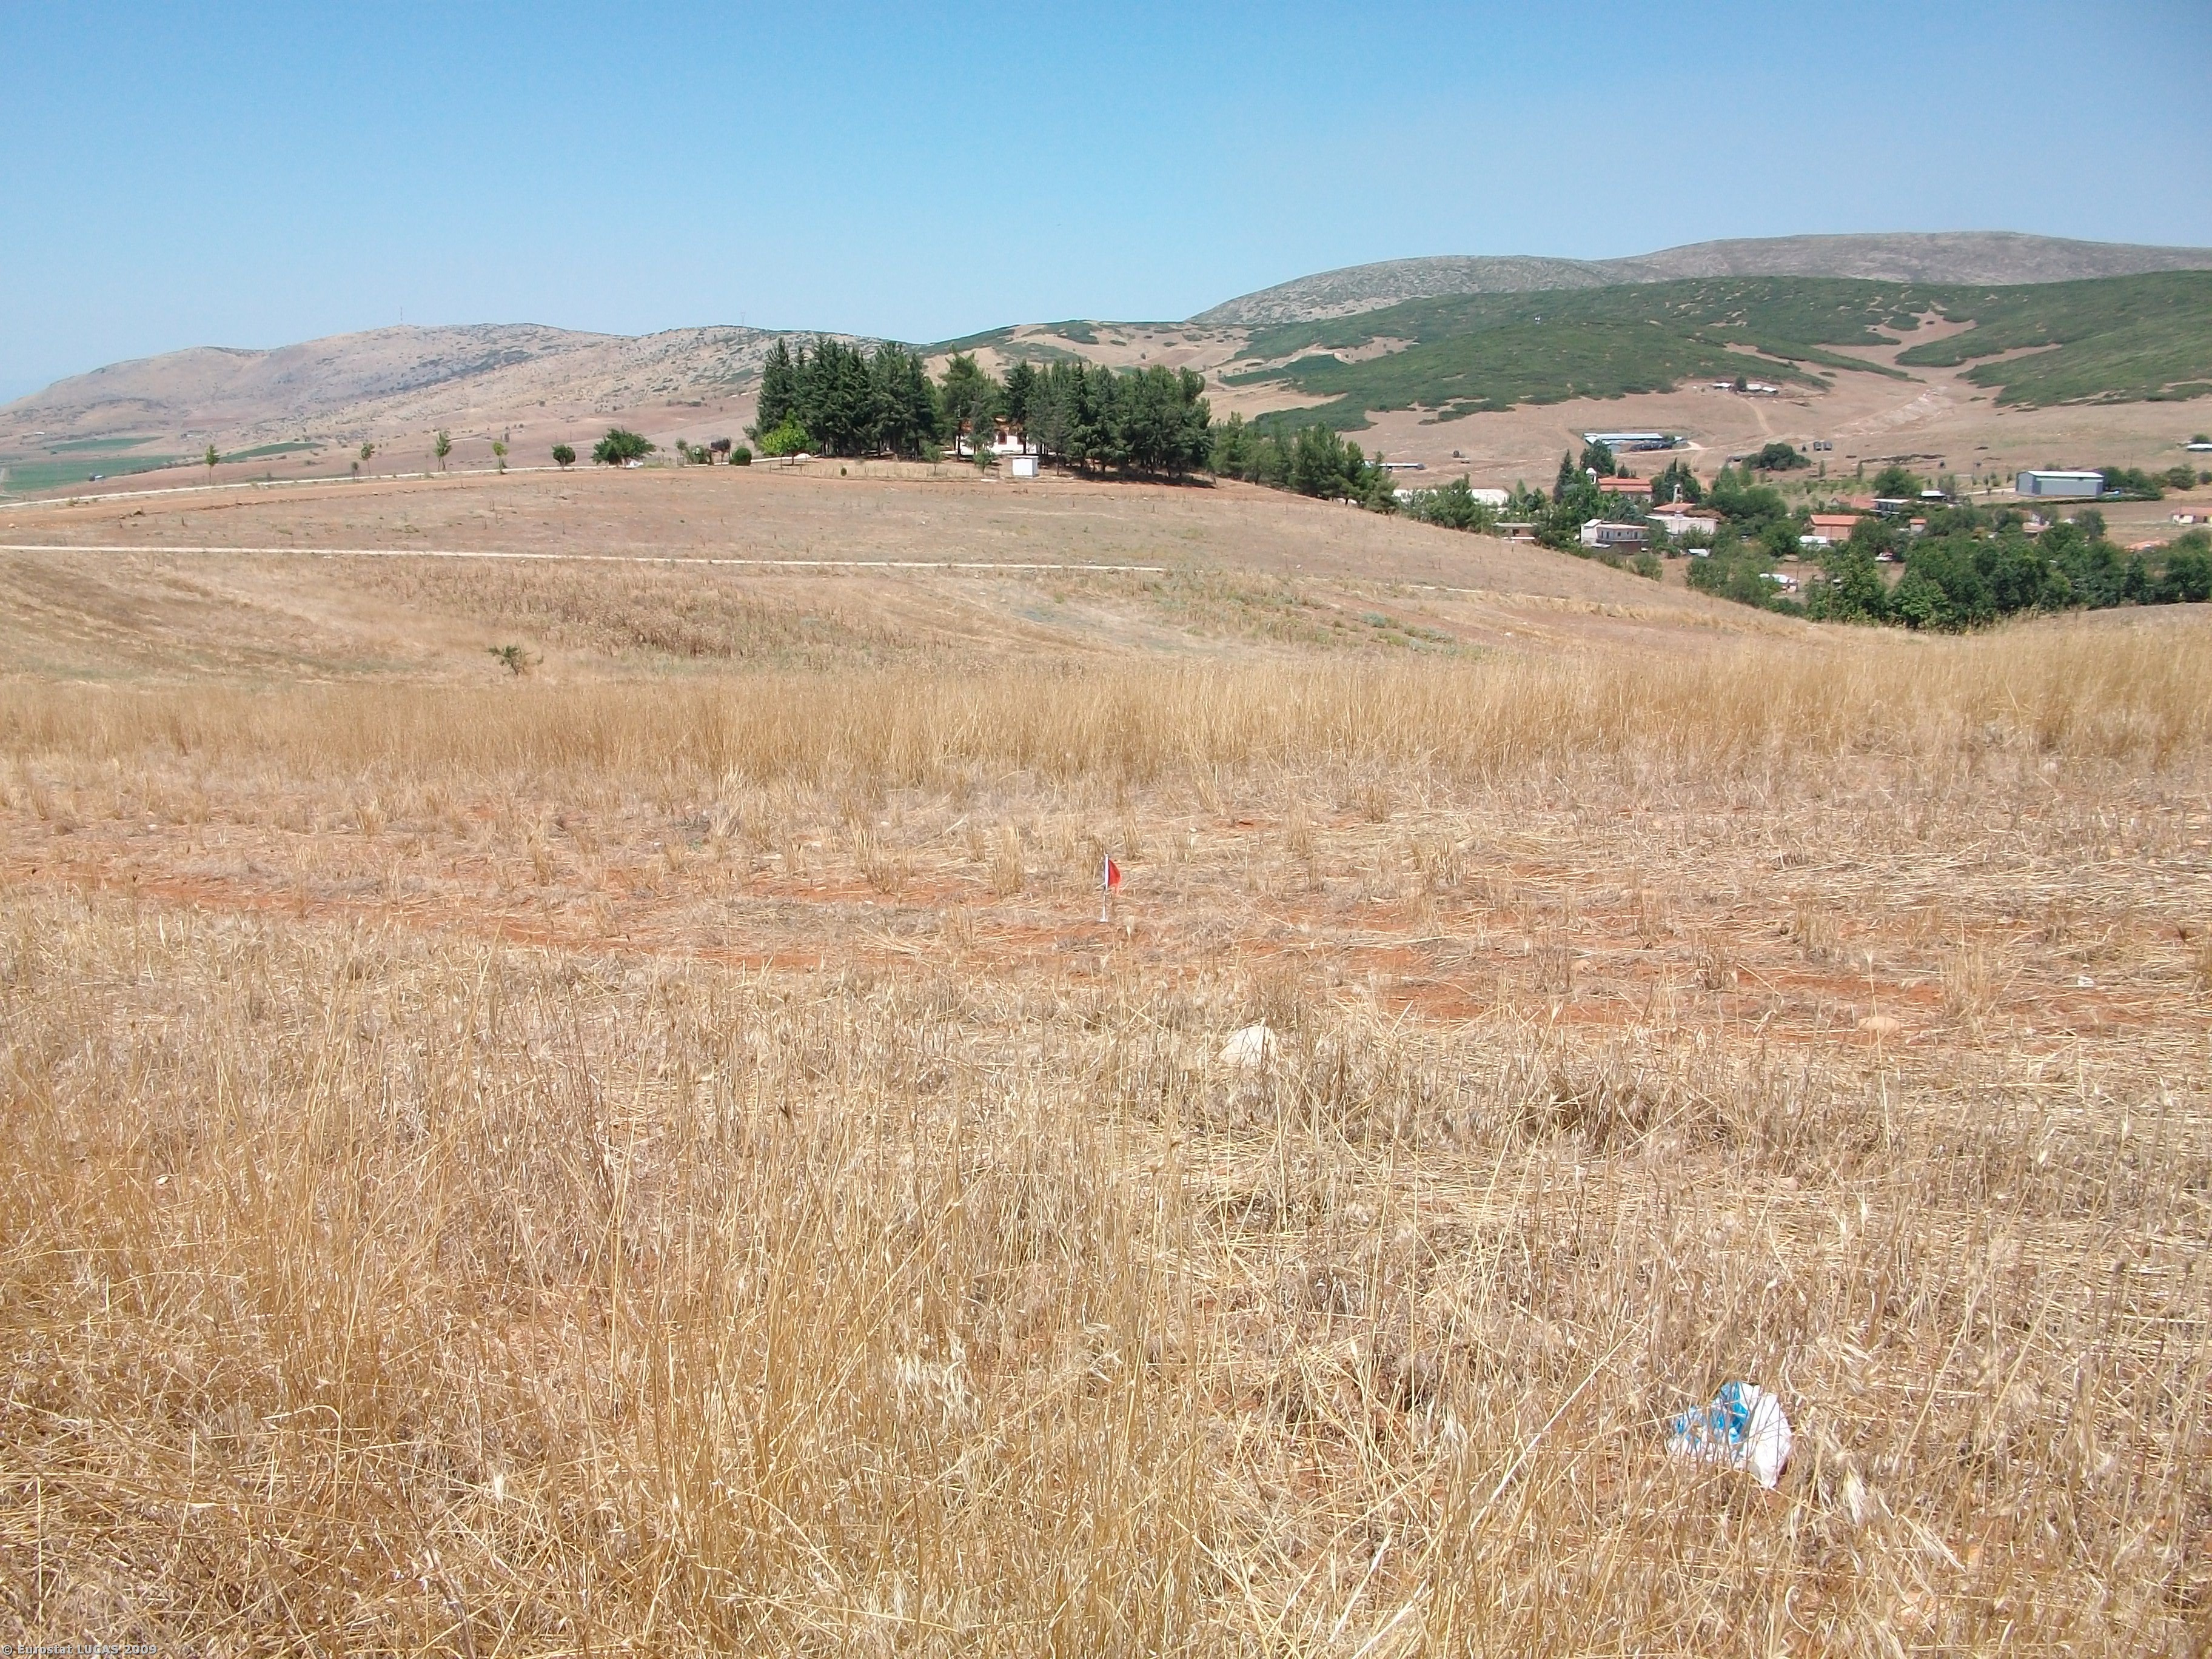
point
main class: Cropland
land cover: Durum wheat
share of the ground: > 75 %
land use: Agriculture (excluding fallow land and kitchen gardens)
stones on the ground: 10 - 25 %
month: July
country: GR
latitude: 39.1957
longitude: 22.3147
